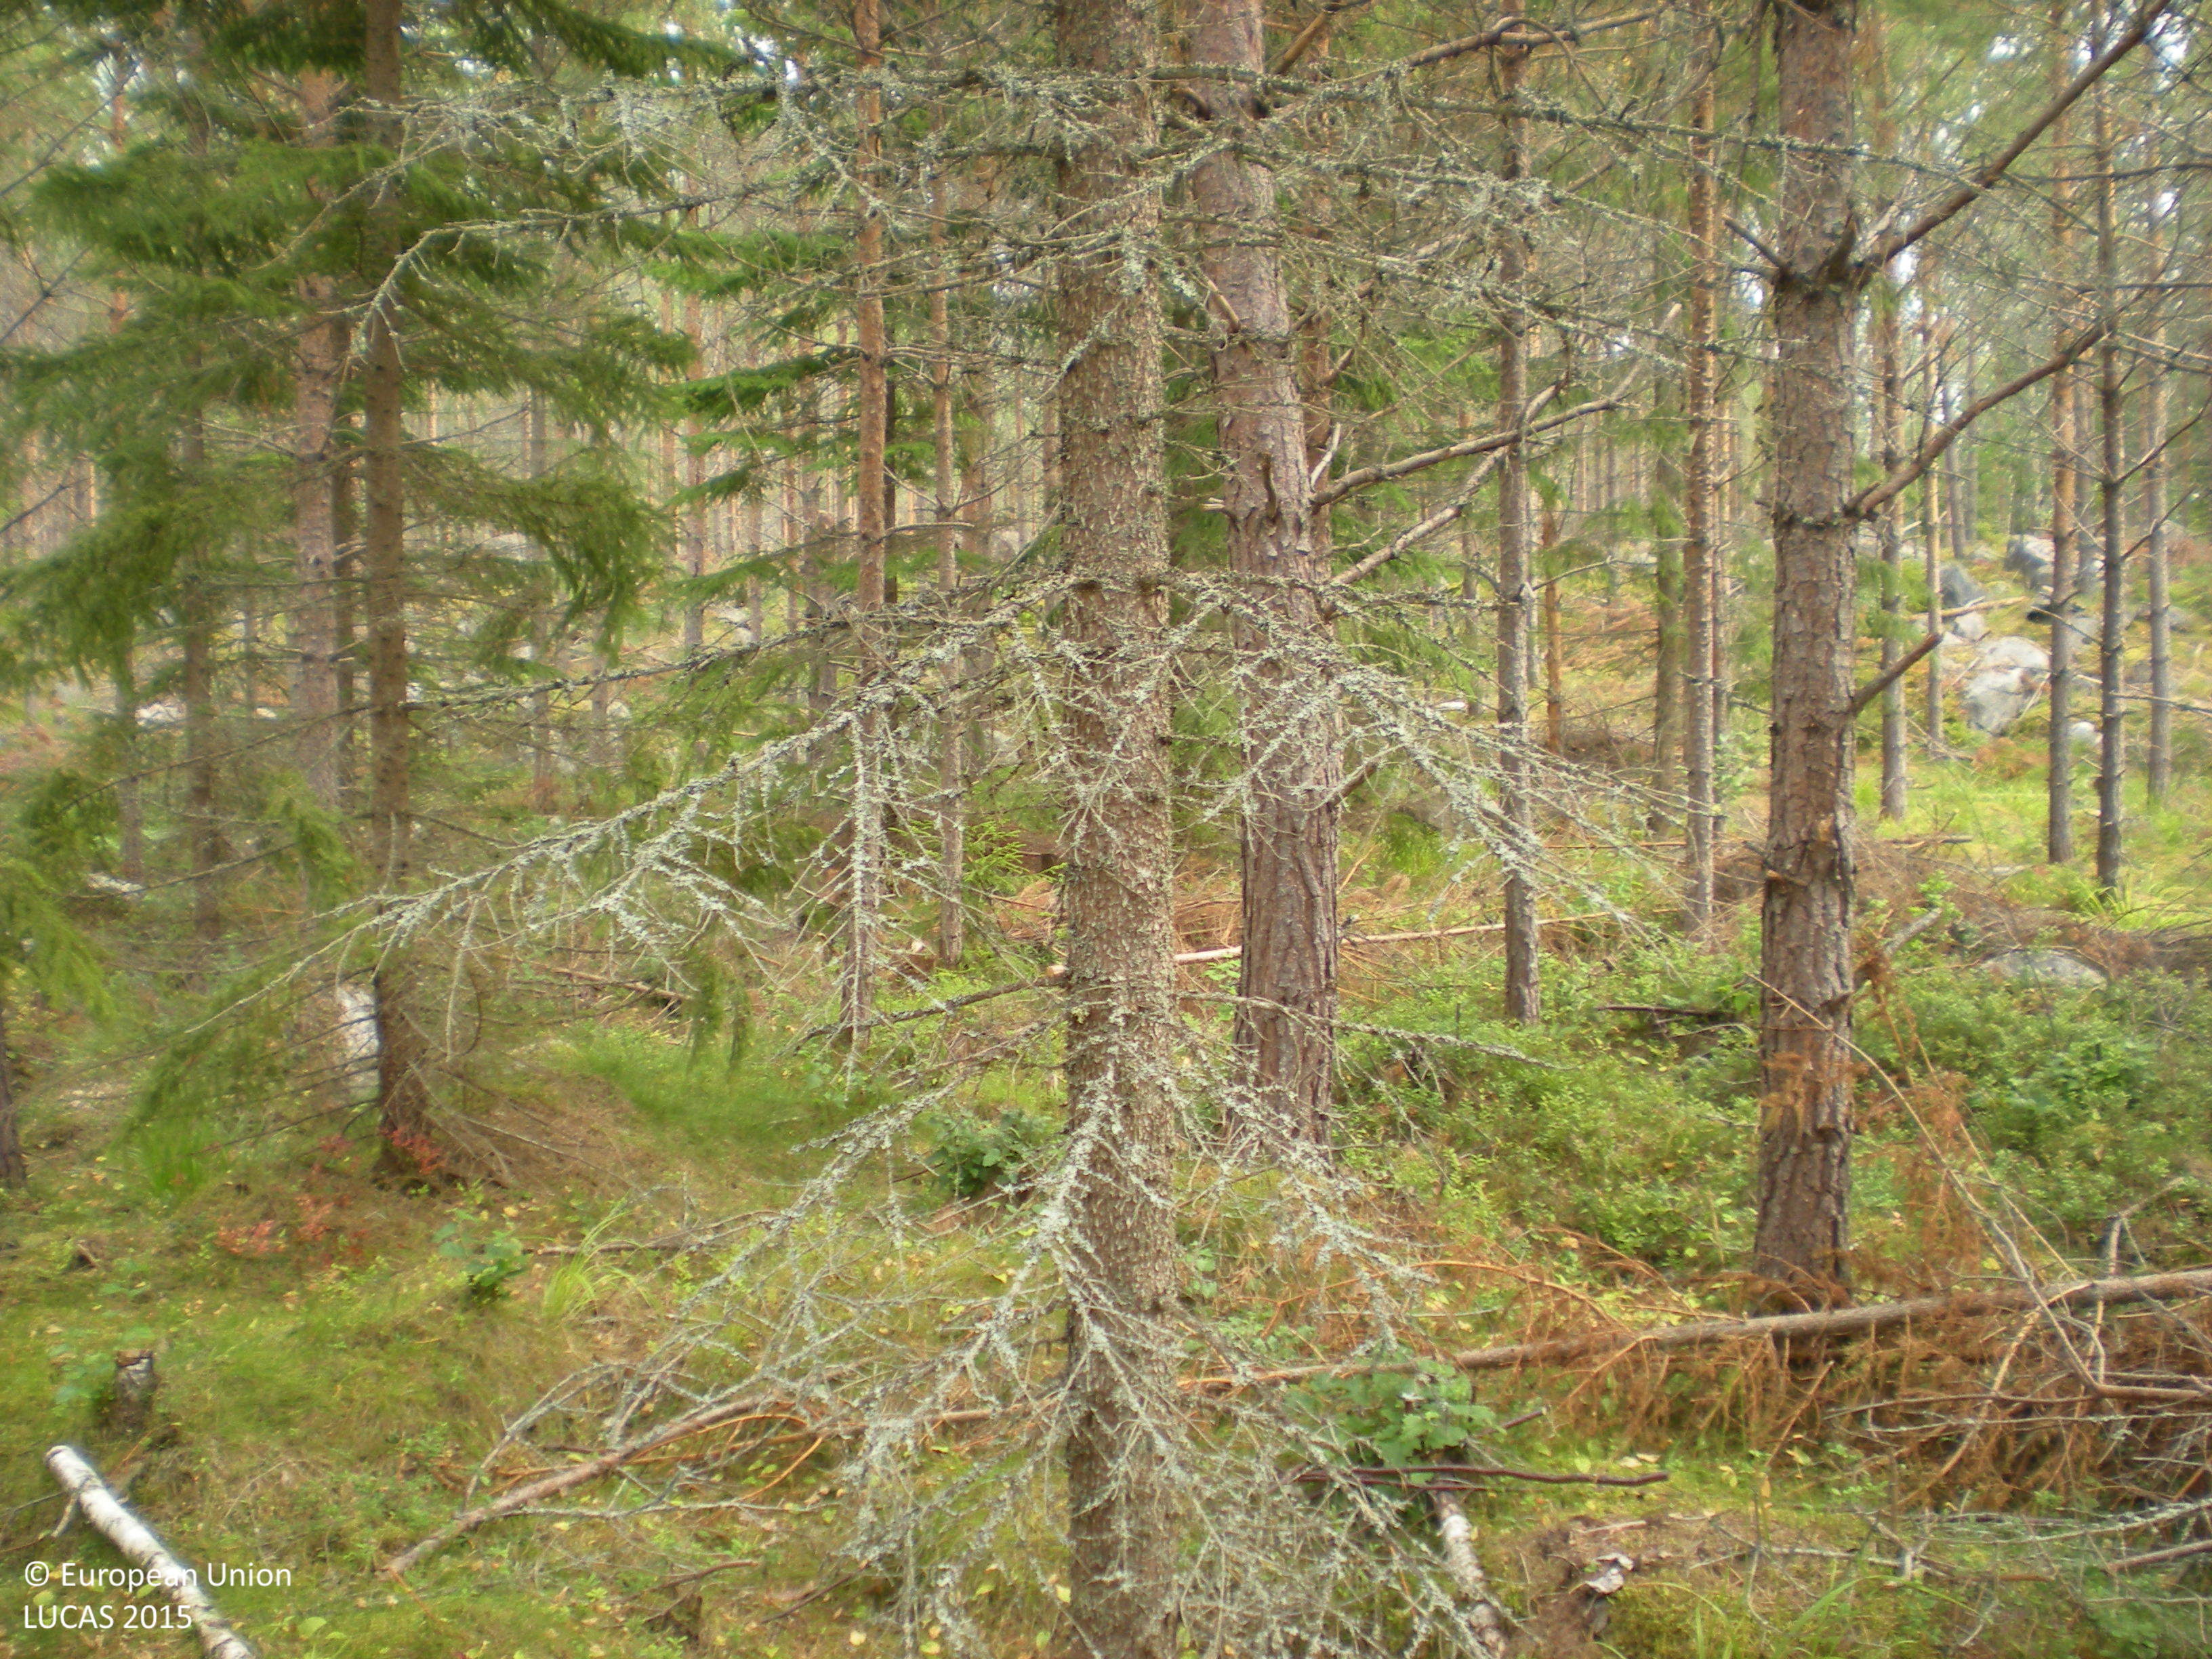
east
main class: Woodland
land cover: Other coniferous woodland
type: boreal forest
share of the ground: 50 - 75 %
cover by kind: coniferous forest trees 60 %, lichens and mosses 15 %, shrubs 10 %, broadleaved forest trees 5 %, herbaceous plants 5 %, consolidated bare surface 5 %
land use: Forestry
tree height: > 5 m
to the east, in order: Other coniferous woodland; Pine dominated coniferous woodland; Tracks; Pine dominated coniferous woodland; Tracks; Pine dominated coniferous woodland
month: August
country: SE
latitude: 60.4419
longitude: 17.6790
